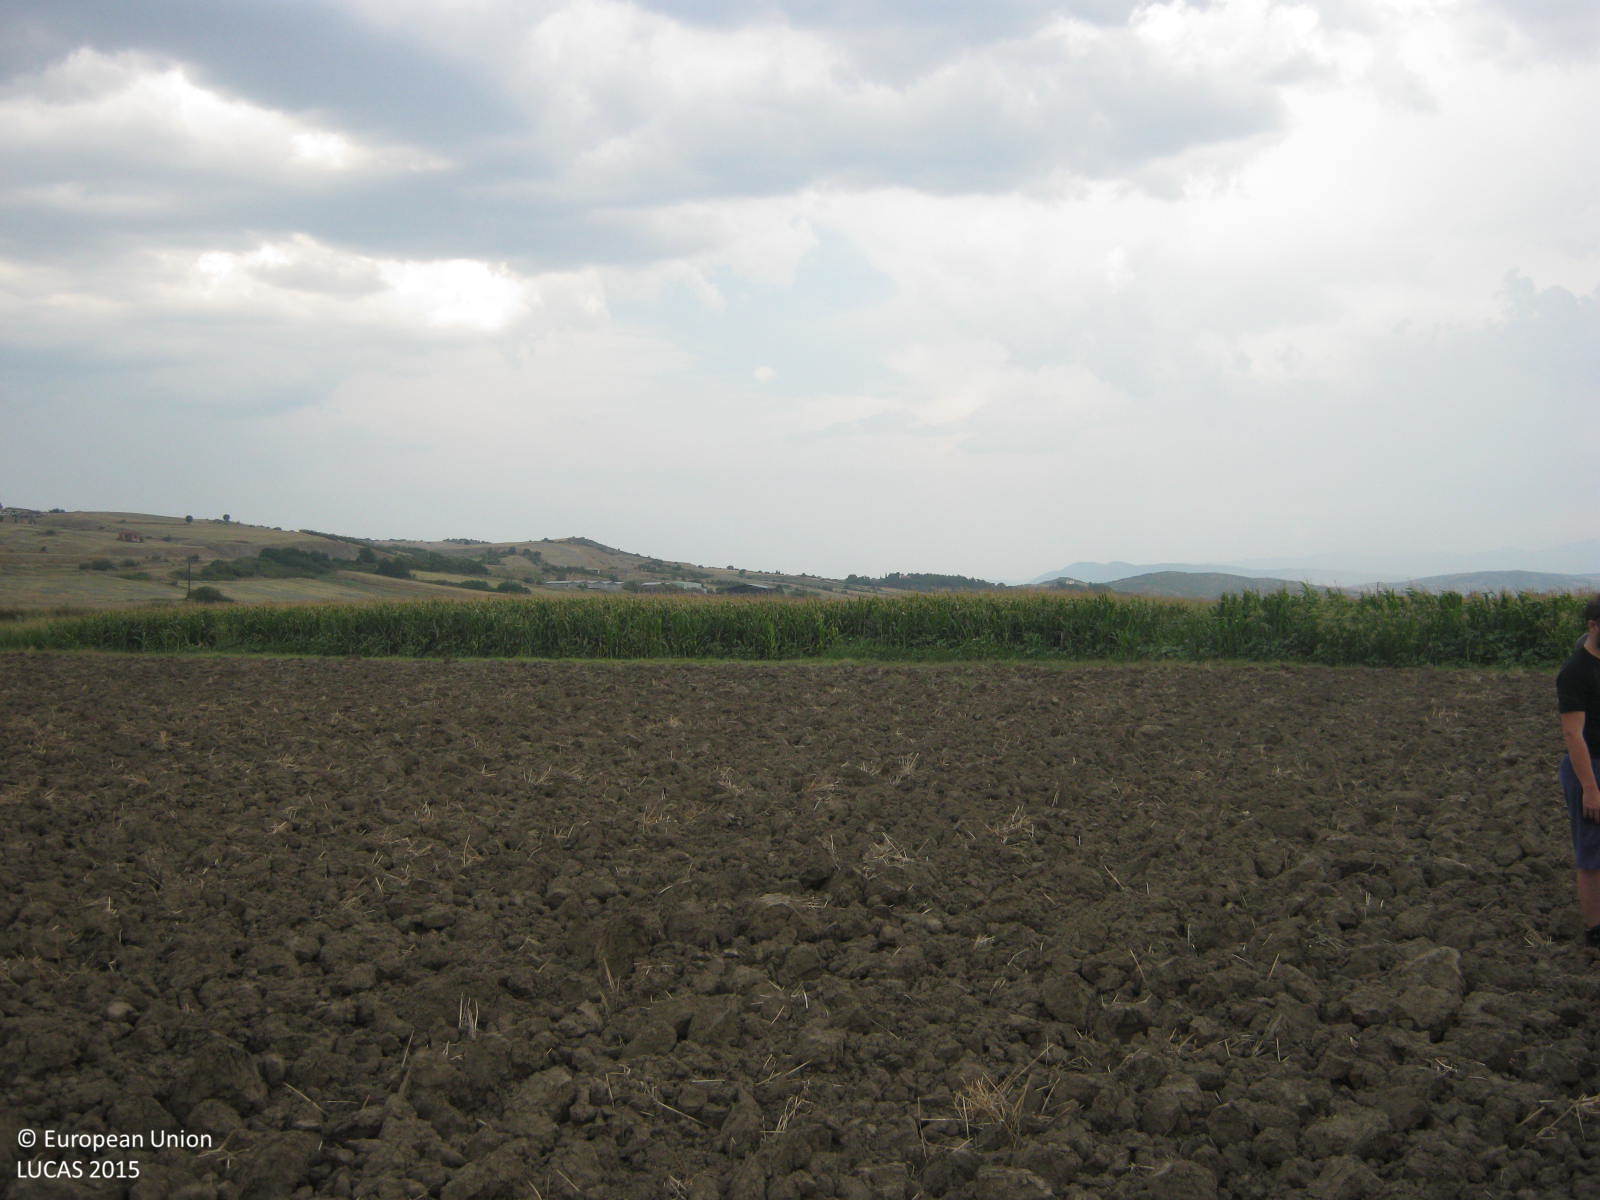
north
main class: Cropland
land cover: Sunflower
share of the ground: > 75 %
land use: Agriculture (excluding fallow land and kitchen gardens)
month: August
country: GR
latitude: 41.0056
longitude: 22.5984
